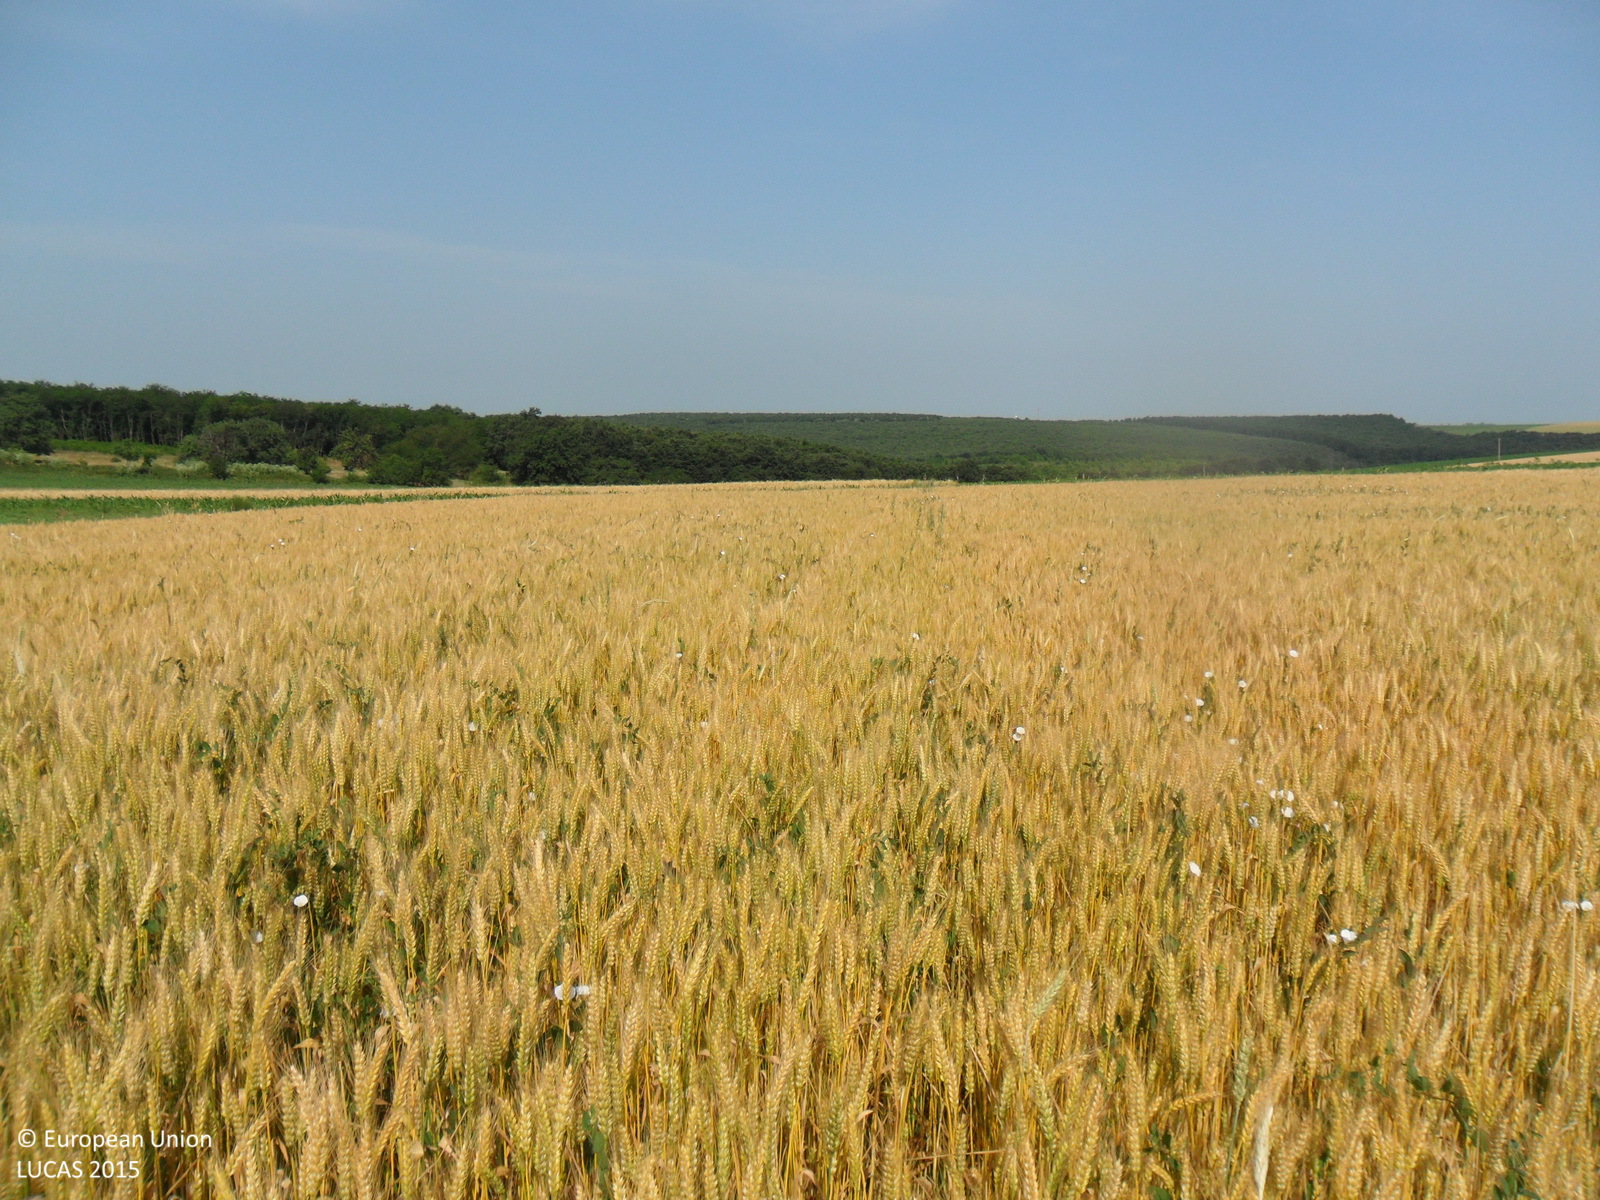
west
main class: Cropland
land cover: Common wheat
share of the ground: > 75 %
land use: Agriculture (excluding fallow land and kitchen gardens)
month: June
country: BG
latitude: 43.6876
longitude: 26.9023
